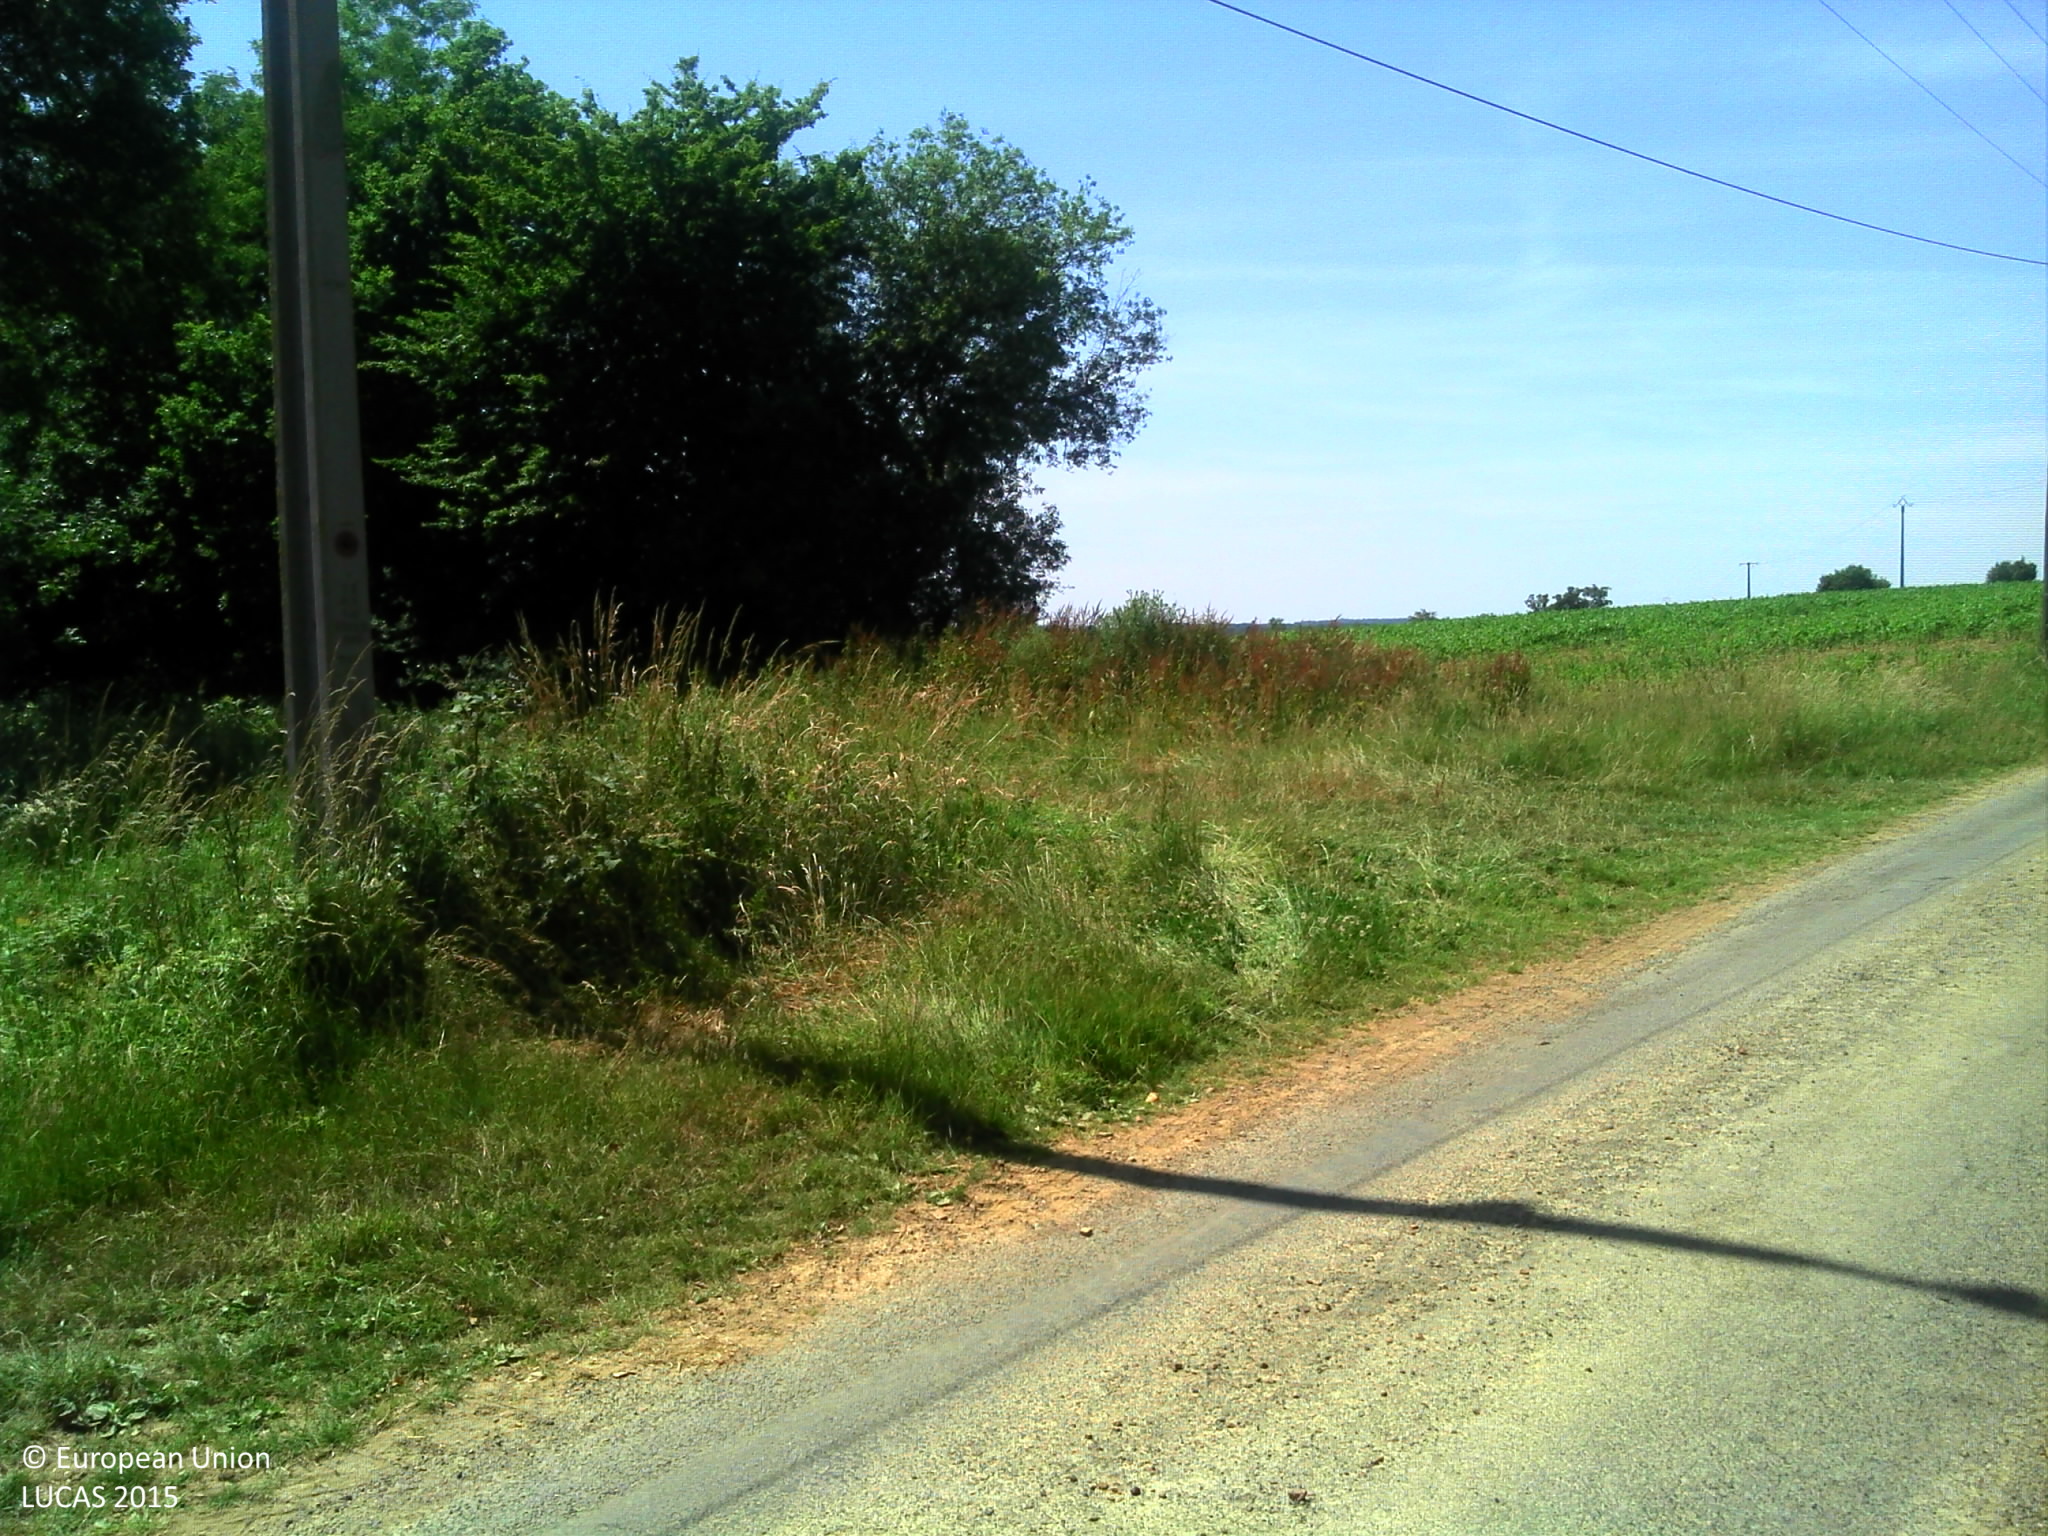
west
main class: Cropland
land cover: Common wheat
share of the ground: > 75 %
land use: Agriculture (excluding fallow land and kitchen gardens)
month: June
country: FR
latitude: 48.7627
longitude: -0.2221
